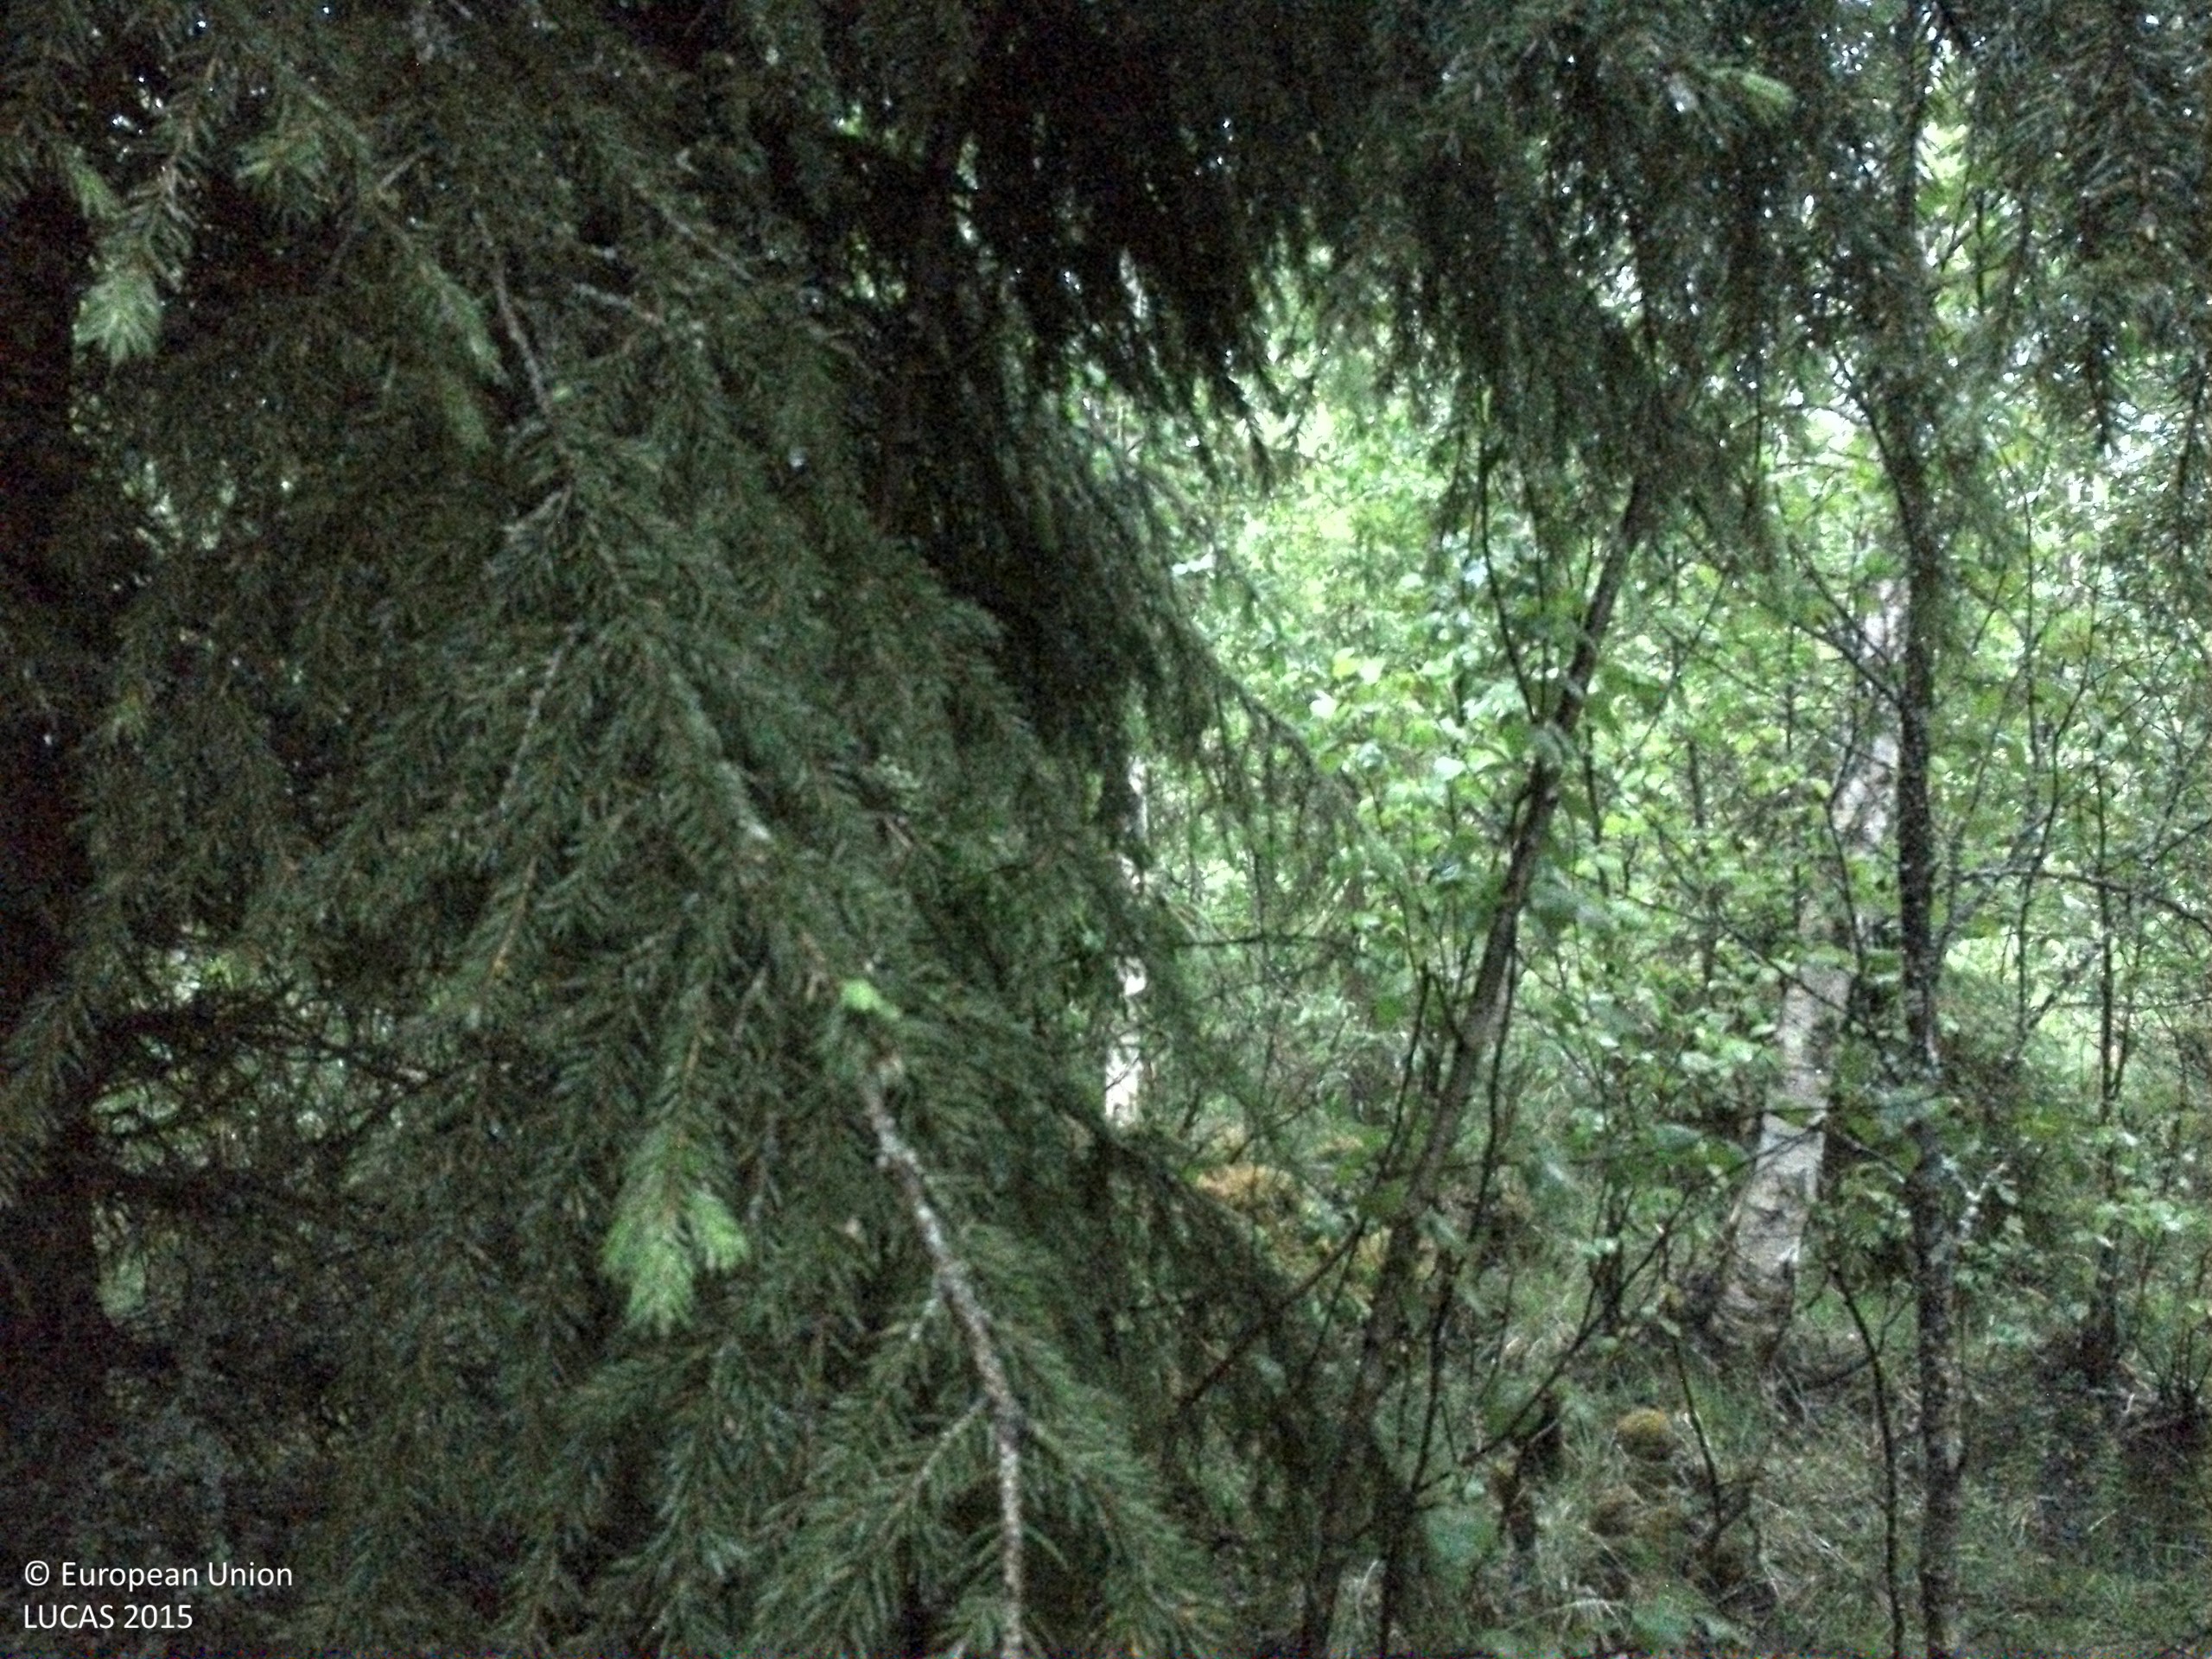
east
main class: Woodland
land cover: Other mixed woodland
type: boreal forest
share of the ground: > 75 %
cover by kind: broadleaved forest trees 45 %, coniferous forest trees 40 %, herbaceous plants 10 %, lichens and mosses 5 %
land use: Forestry
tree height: > 5 m
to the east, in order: Other mixed woodland; Shruby margins; Ditches and canals; Paved roads, cycling and walking lanes; Shruby margins; Other mixed woodland; Ditches and canals; Other mixed woodland; Rivers and streams; Other mixed woodland
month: July
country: SE
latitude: 64.4784
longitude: 16.1468
